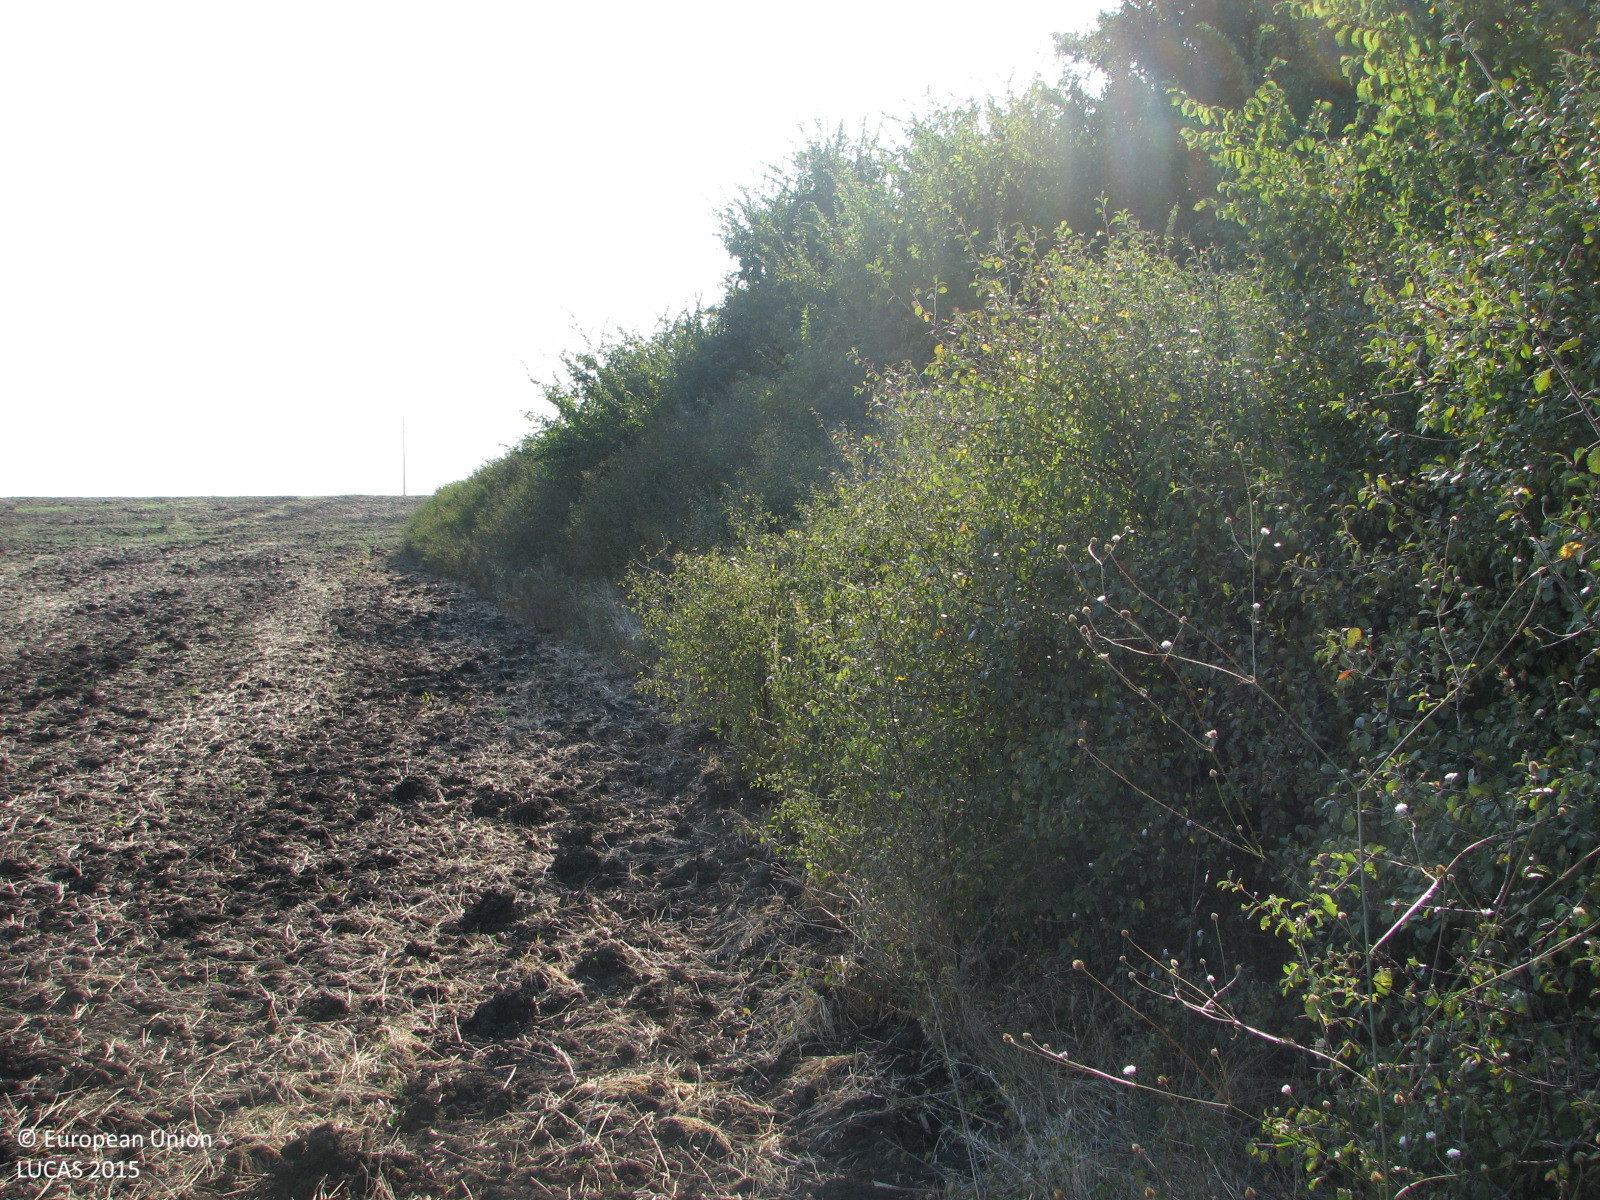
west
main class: Woodland
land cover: Broadleaved woodland
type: mesophytic deciduous forest
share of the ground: > 75 %
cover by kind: broadleaved forest trees 100 %
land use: Semi-natural and natural areas not in use
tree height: > 5 m
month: September
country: BG
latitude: 42.3438
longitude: 26.6879
